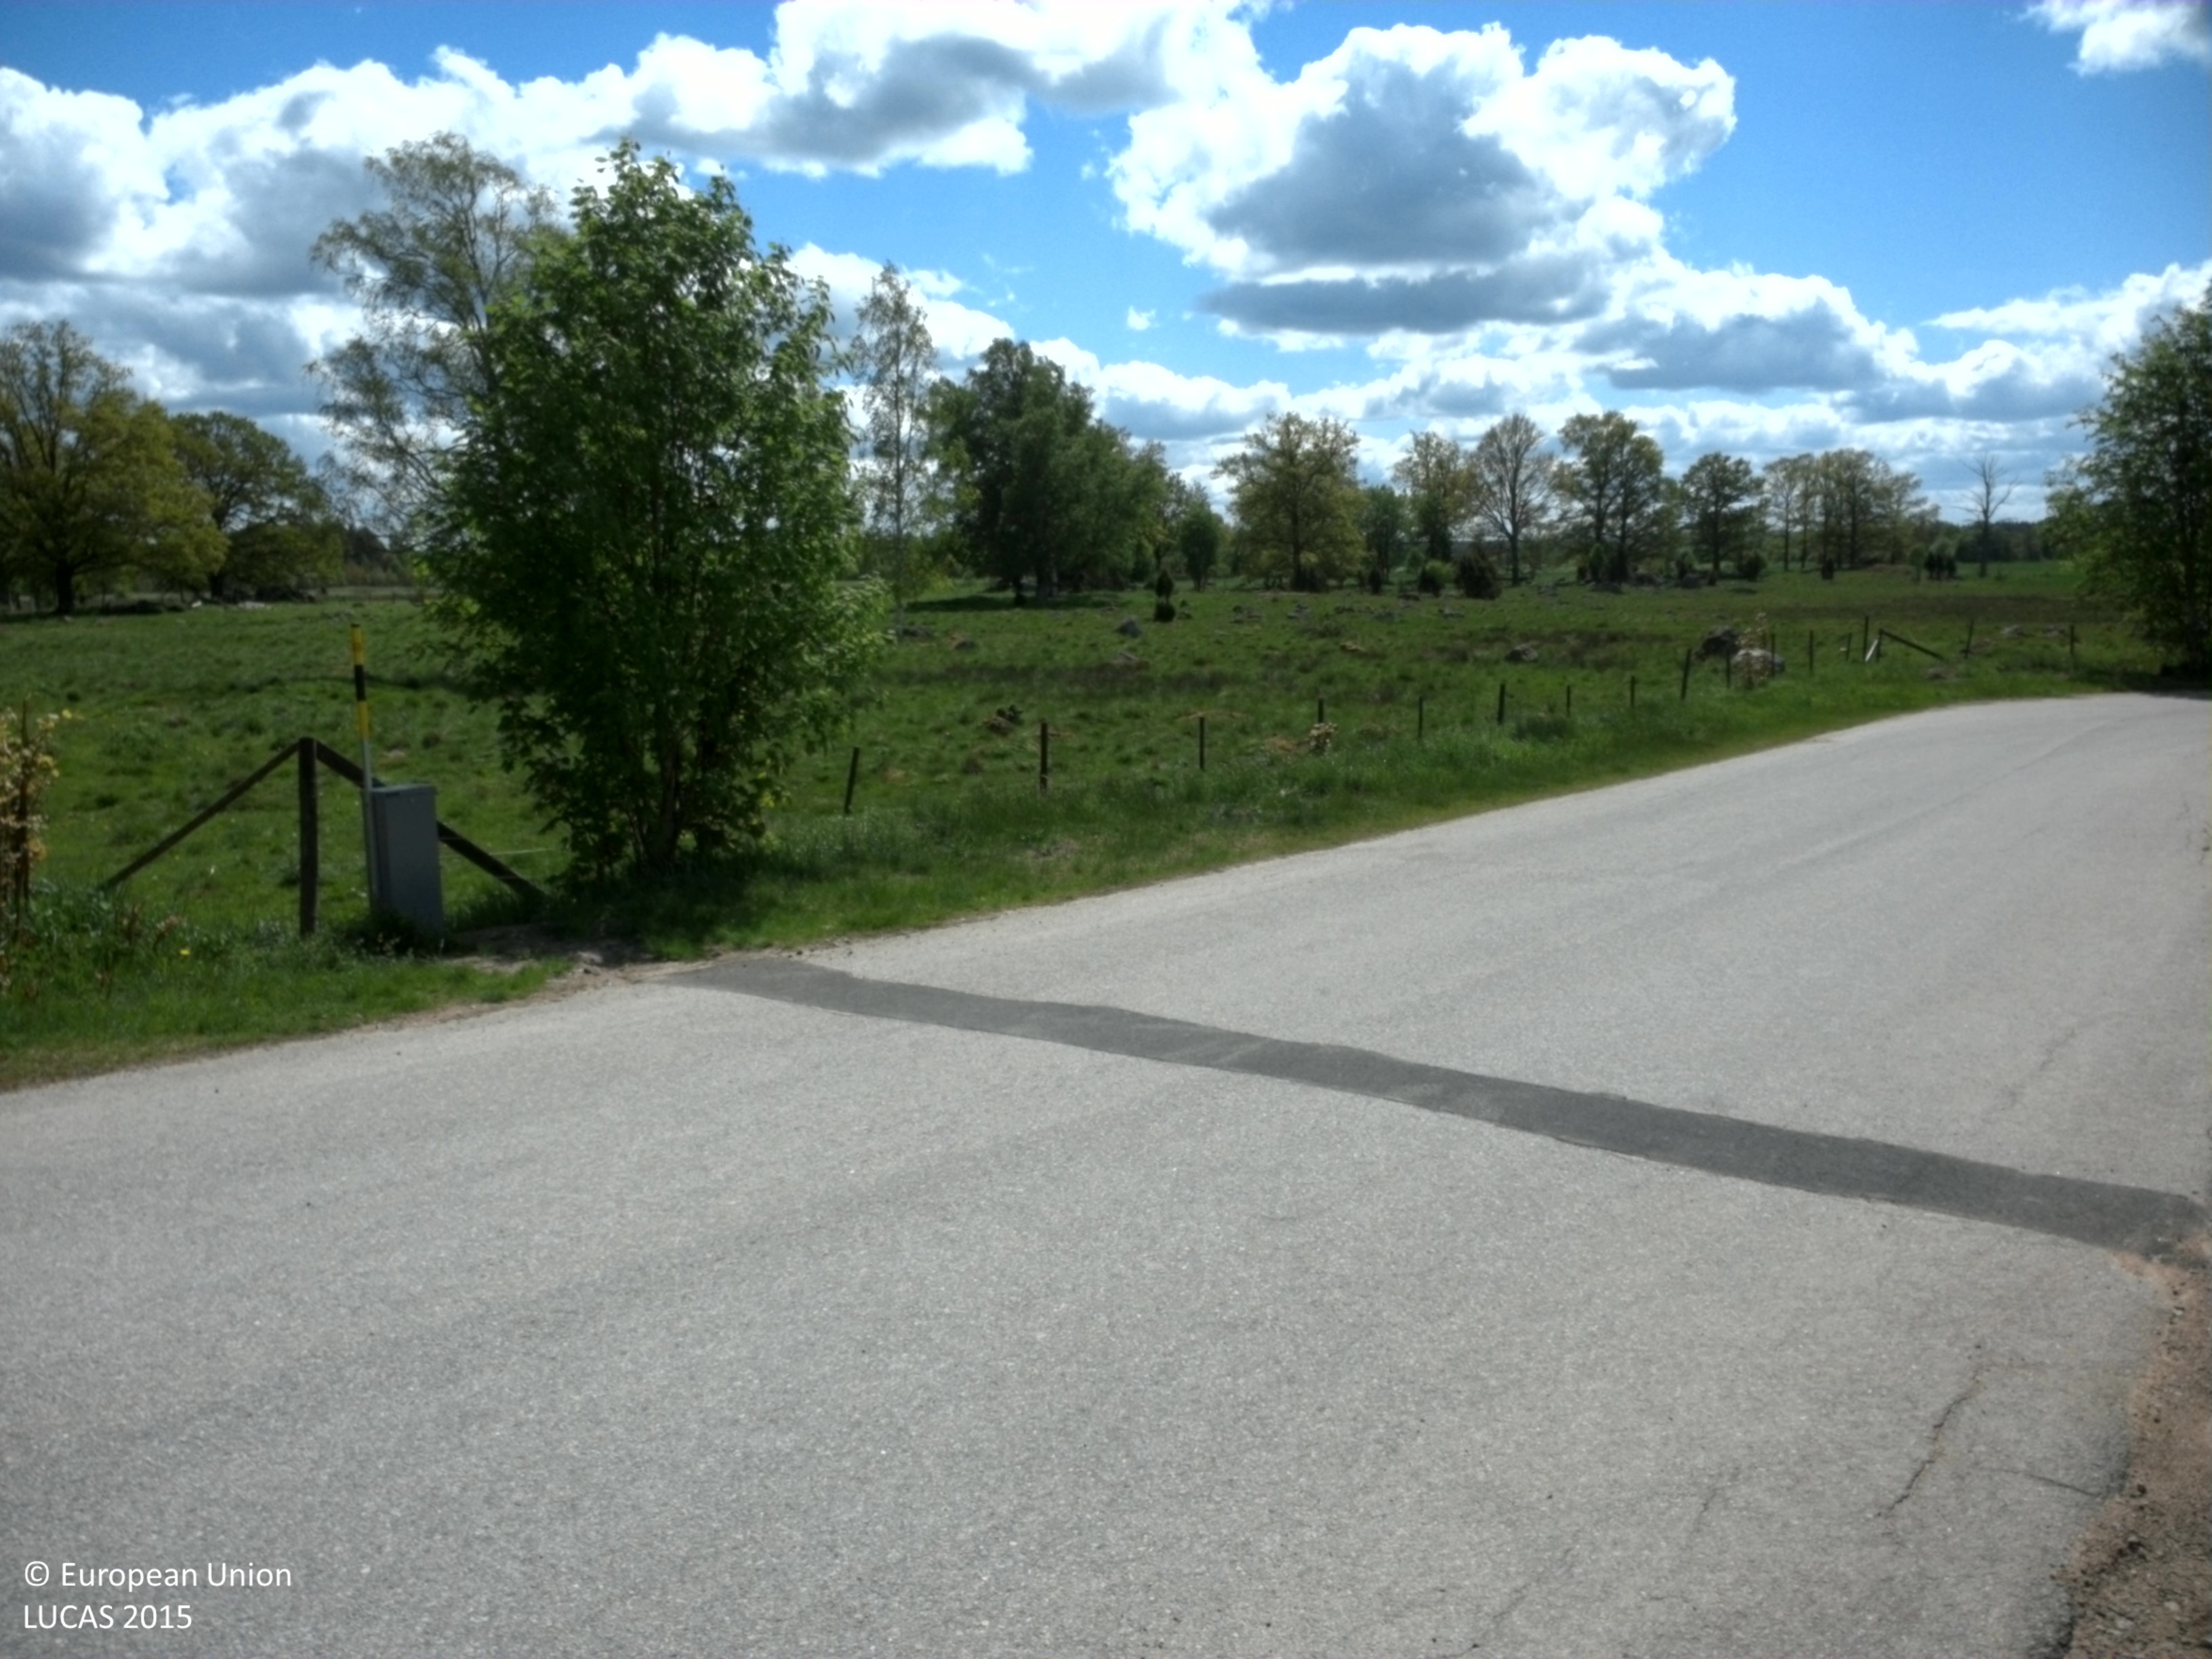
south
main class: Grassland
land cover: Grassland with sparse tree/shrub cover
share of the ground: > 75 %
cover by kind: herbaceous plants 80 %, broadleaved forest trees 5 %, shrubs 5 %, lichens and mosses 5 %, unconsolidated bare surface 5 %
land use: Residential
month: May
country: SE
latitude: 57.3162
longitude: 15.8591
